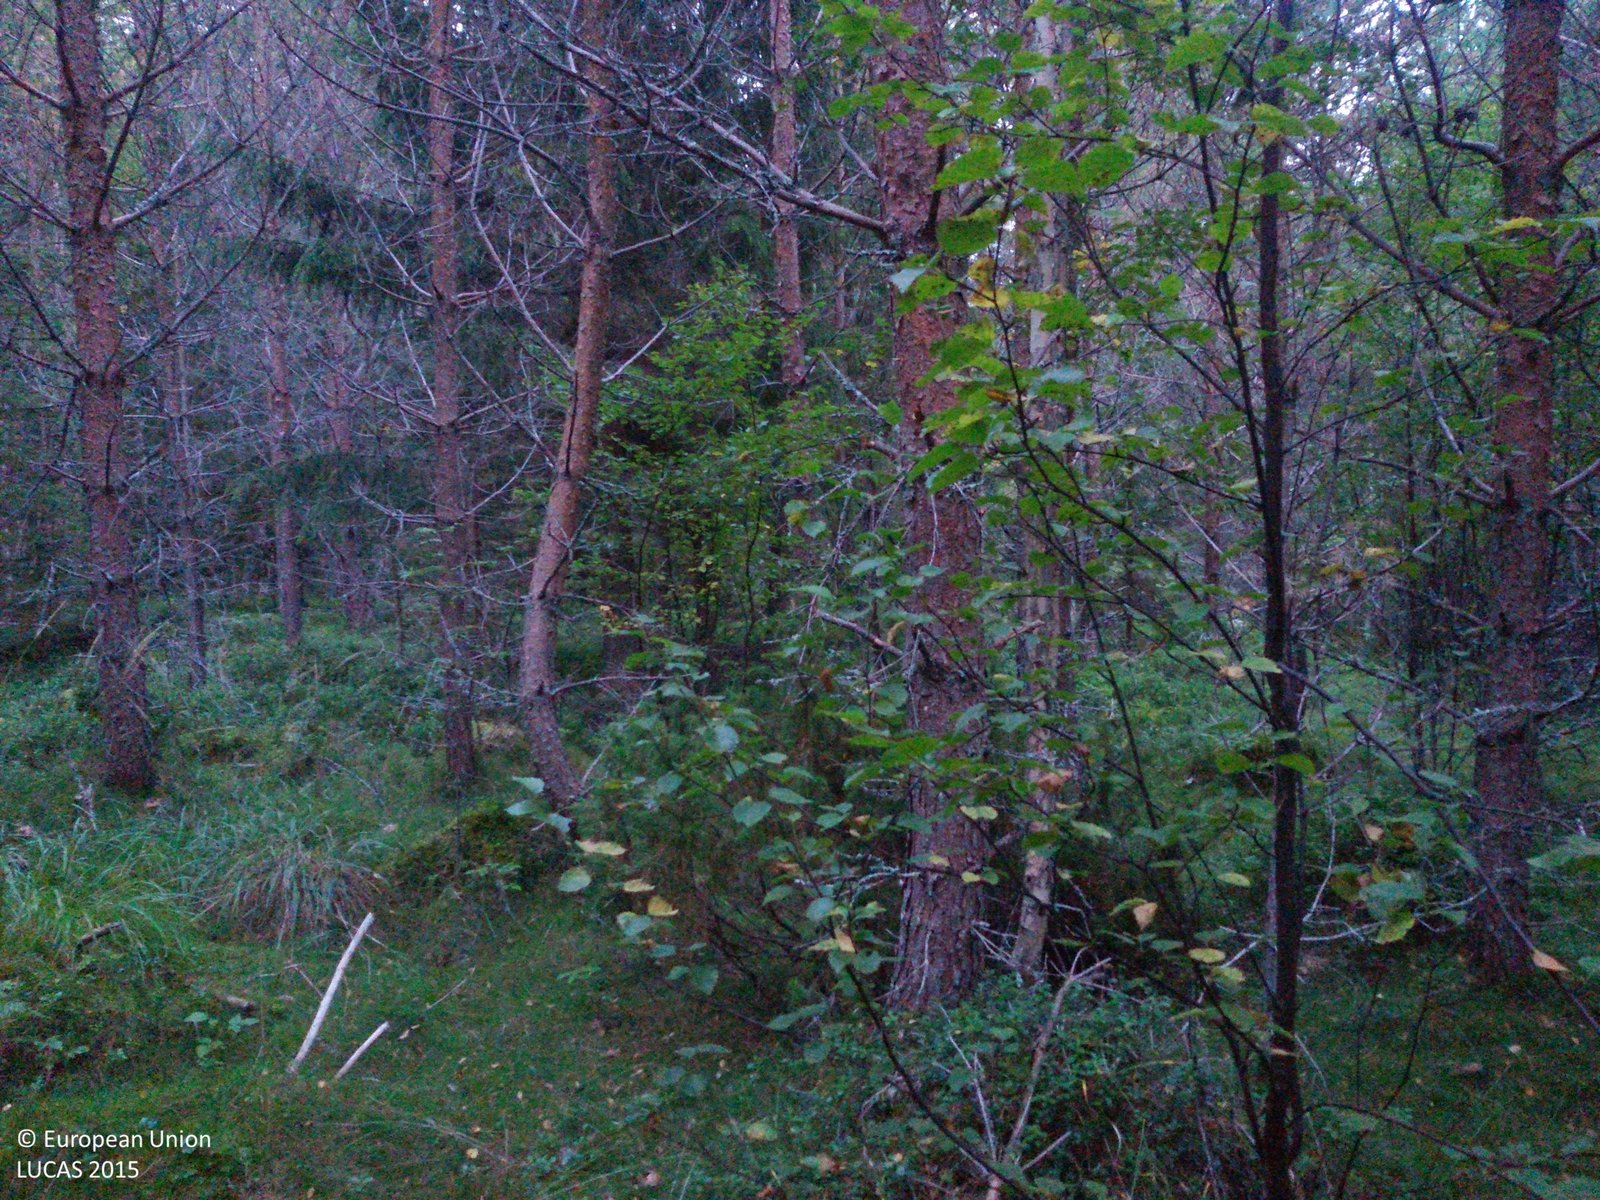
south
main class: Woodland
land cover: Pine dominated coniferous woodland
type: boreal forest
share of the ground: > 75 %
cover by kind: coniferous forest trees 80 %, shrubs 15 %, lichens and mosses 5 %
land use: Forestry
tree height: > 5 m
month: September
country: SE
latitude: 60.7148
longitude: 15.2468
